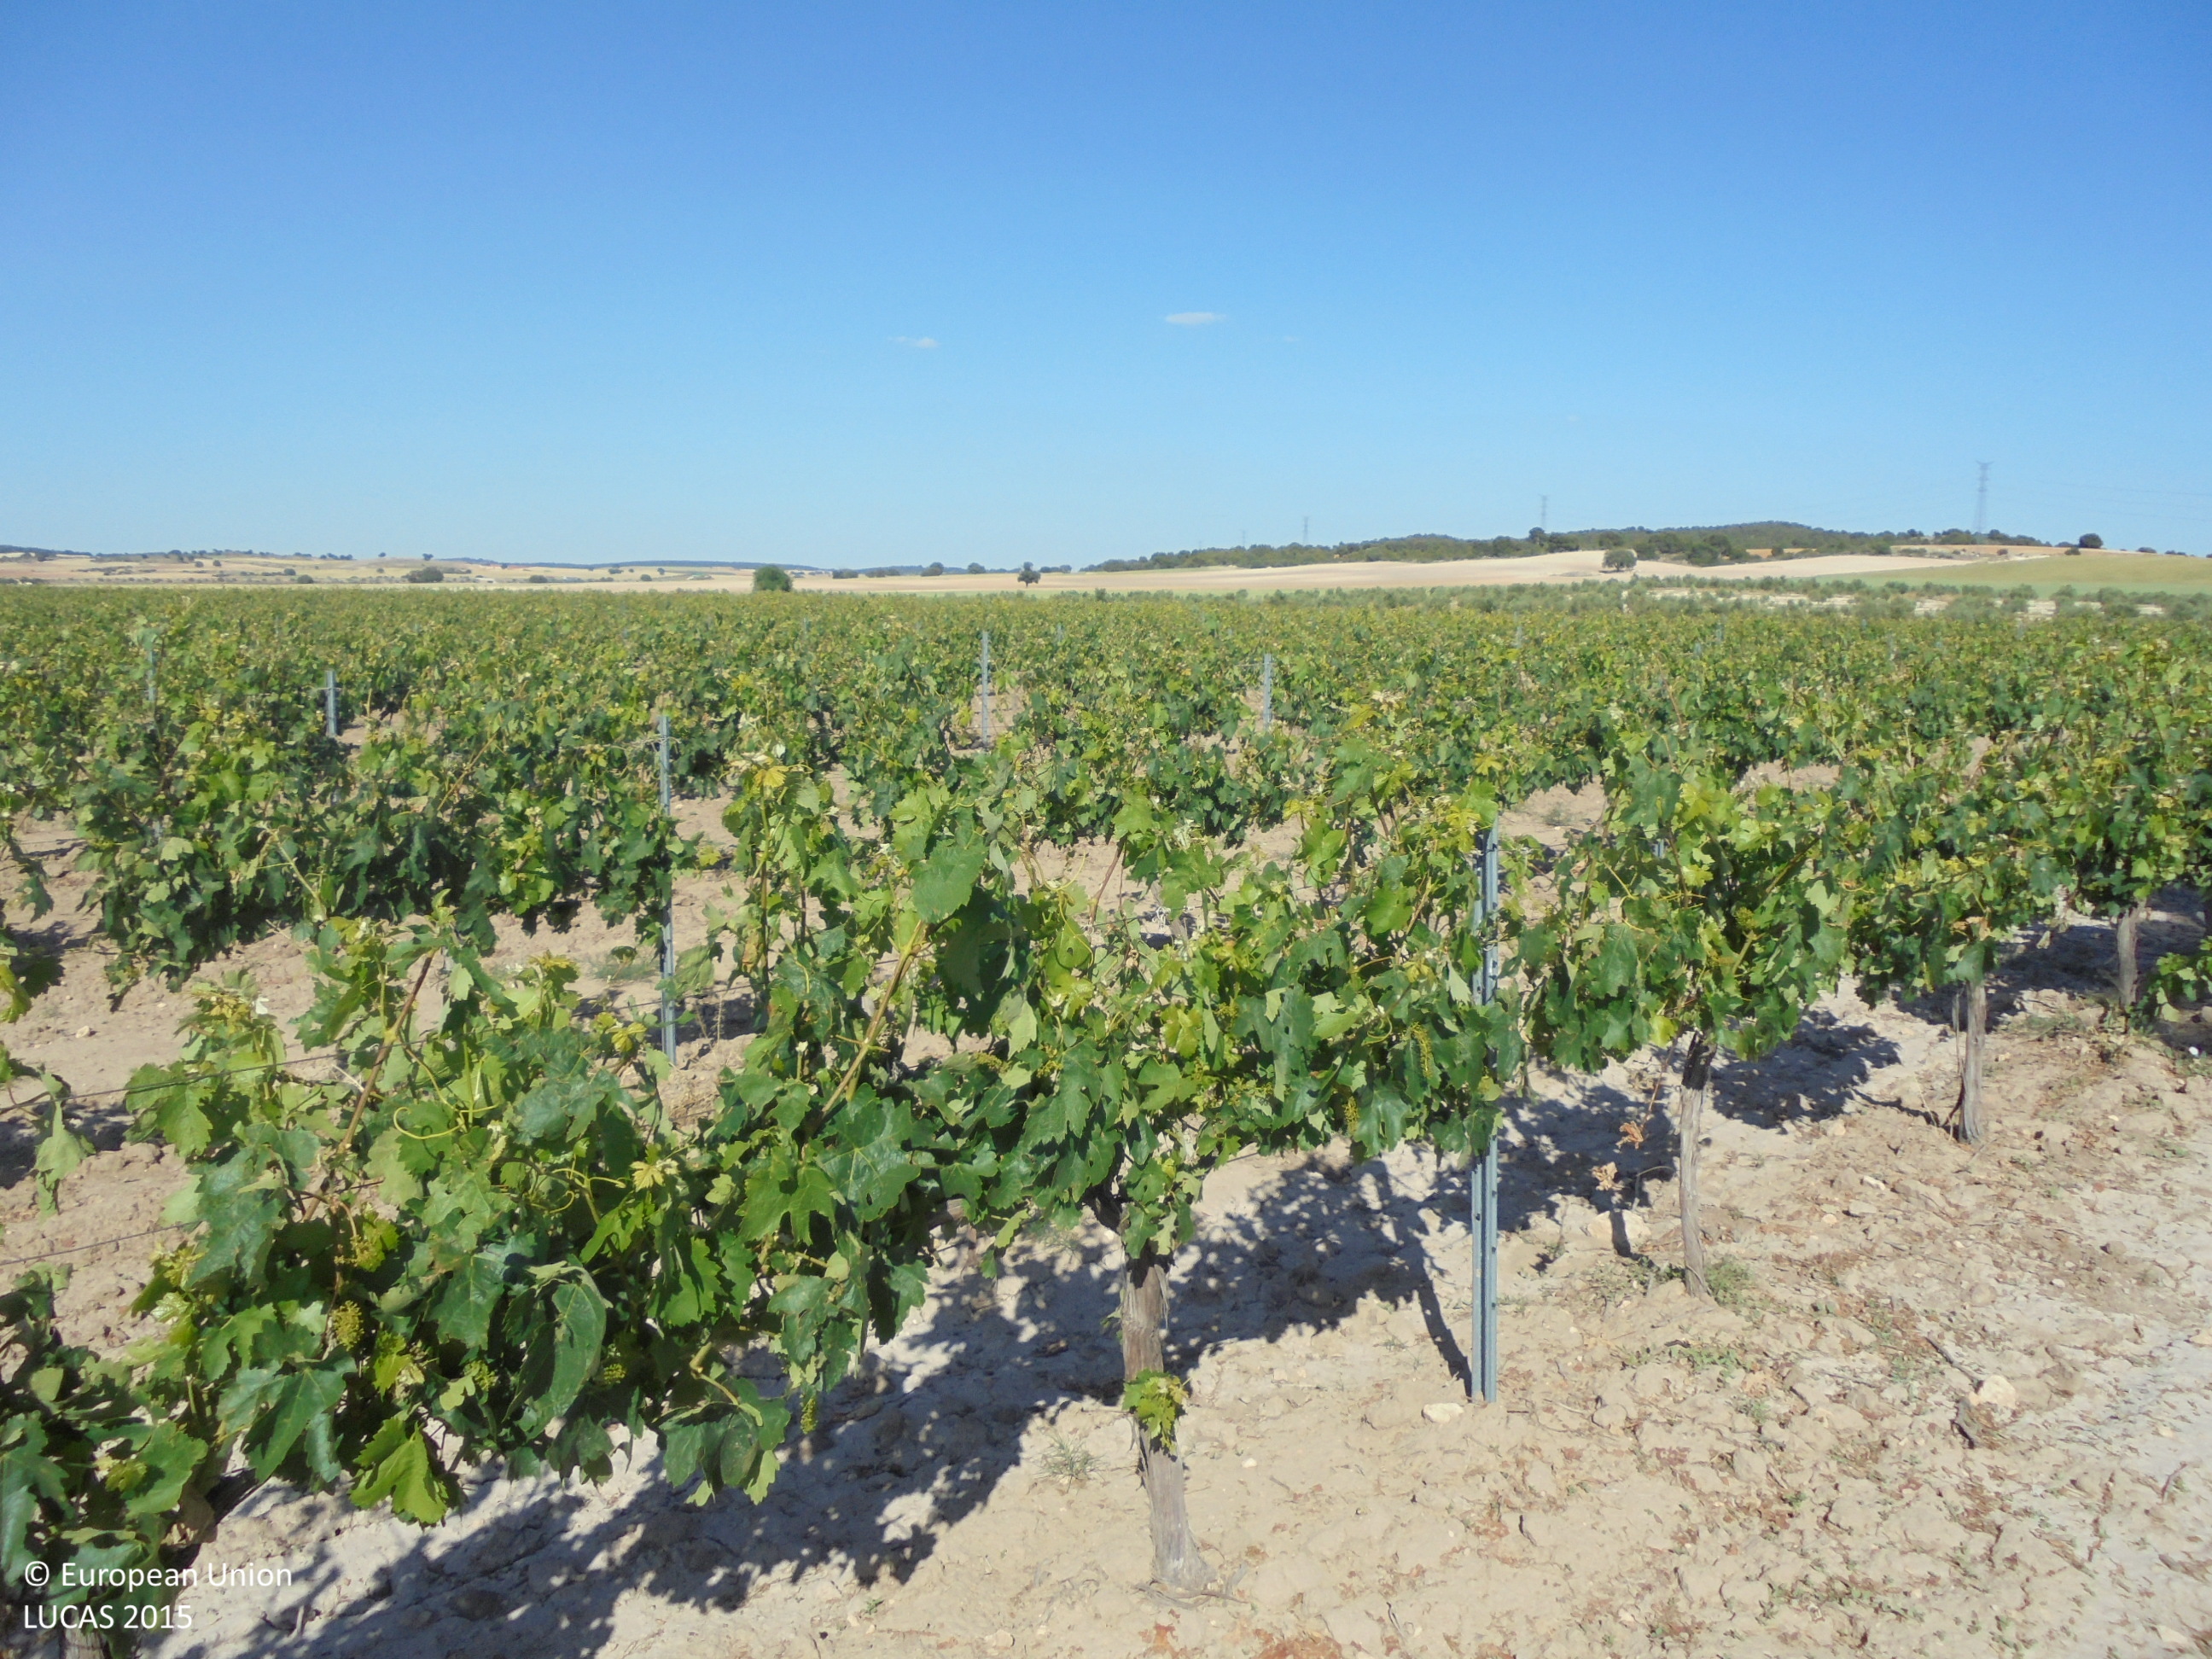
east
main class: Cropland
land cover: Vineyards
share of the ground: 10 - 25 %
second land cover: Other bare soil
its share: > 75 %
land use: Agriculture (excluding fallow land and kitchen gardens)
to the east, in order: Vineyards; Other bare soil; Spontaneously vegetated surfaces; Tracks; Grass margins; Olive groves; Grass margins; Dry stone walls; Grass margins; Olive groves
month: June
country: ES
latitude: 38.7579
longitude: -1.7228
